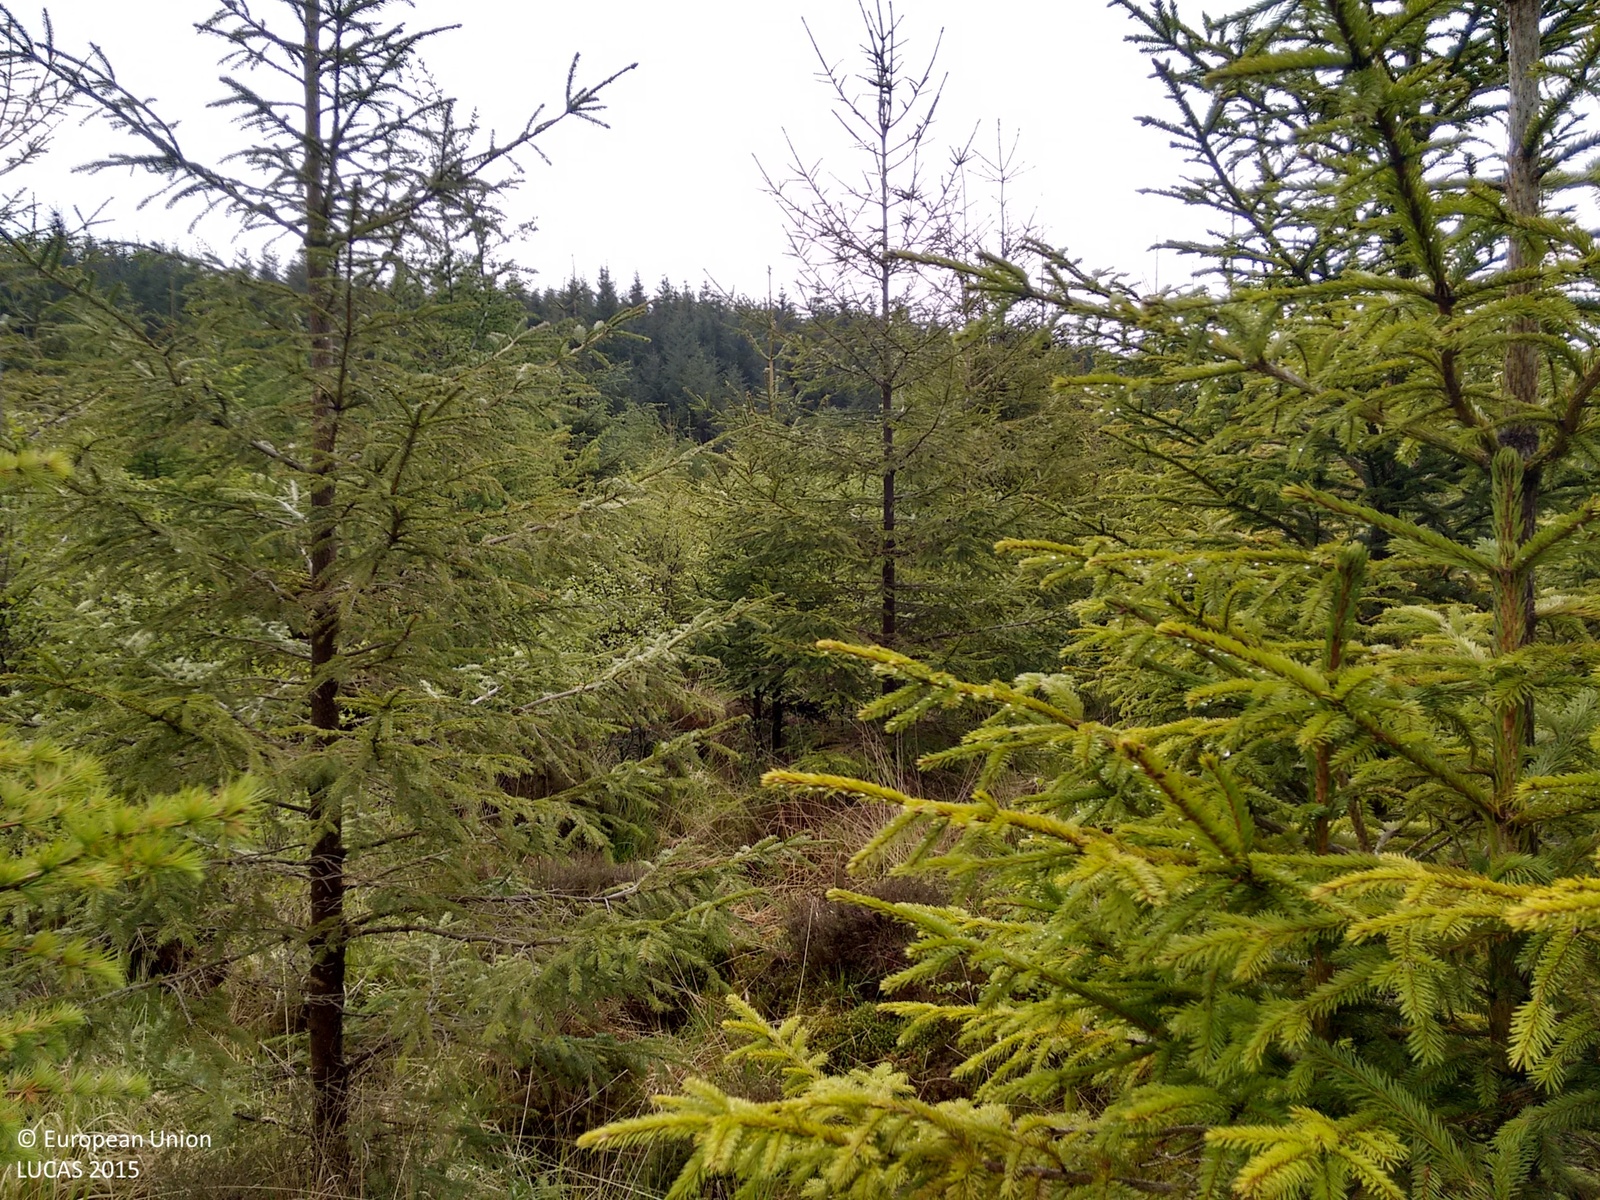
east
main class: Woodland
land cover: Other mixed woodland
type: exotic forest
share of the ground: > 75 %
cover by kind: coniferous forest trees 60 %, broadleaved forest trees 40 %
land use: Forestry
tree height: < 5 m
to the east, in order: Other mixed woodland; Spruce dominated coniferous woodland; Tracks; Rivers and streams; Grassland with sparse tree/shrub cover; Spruce dominated coniferous woodland
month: June
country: GB
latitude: 56.0680
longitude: -5.4613
